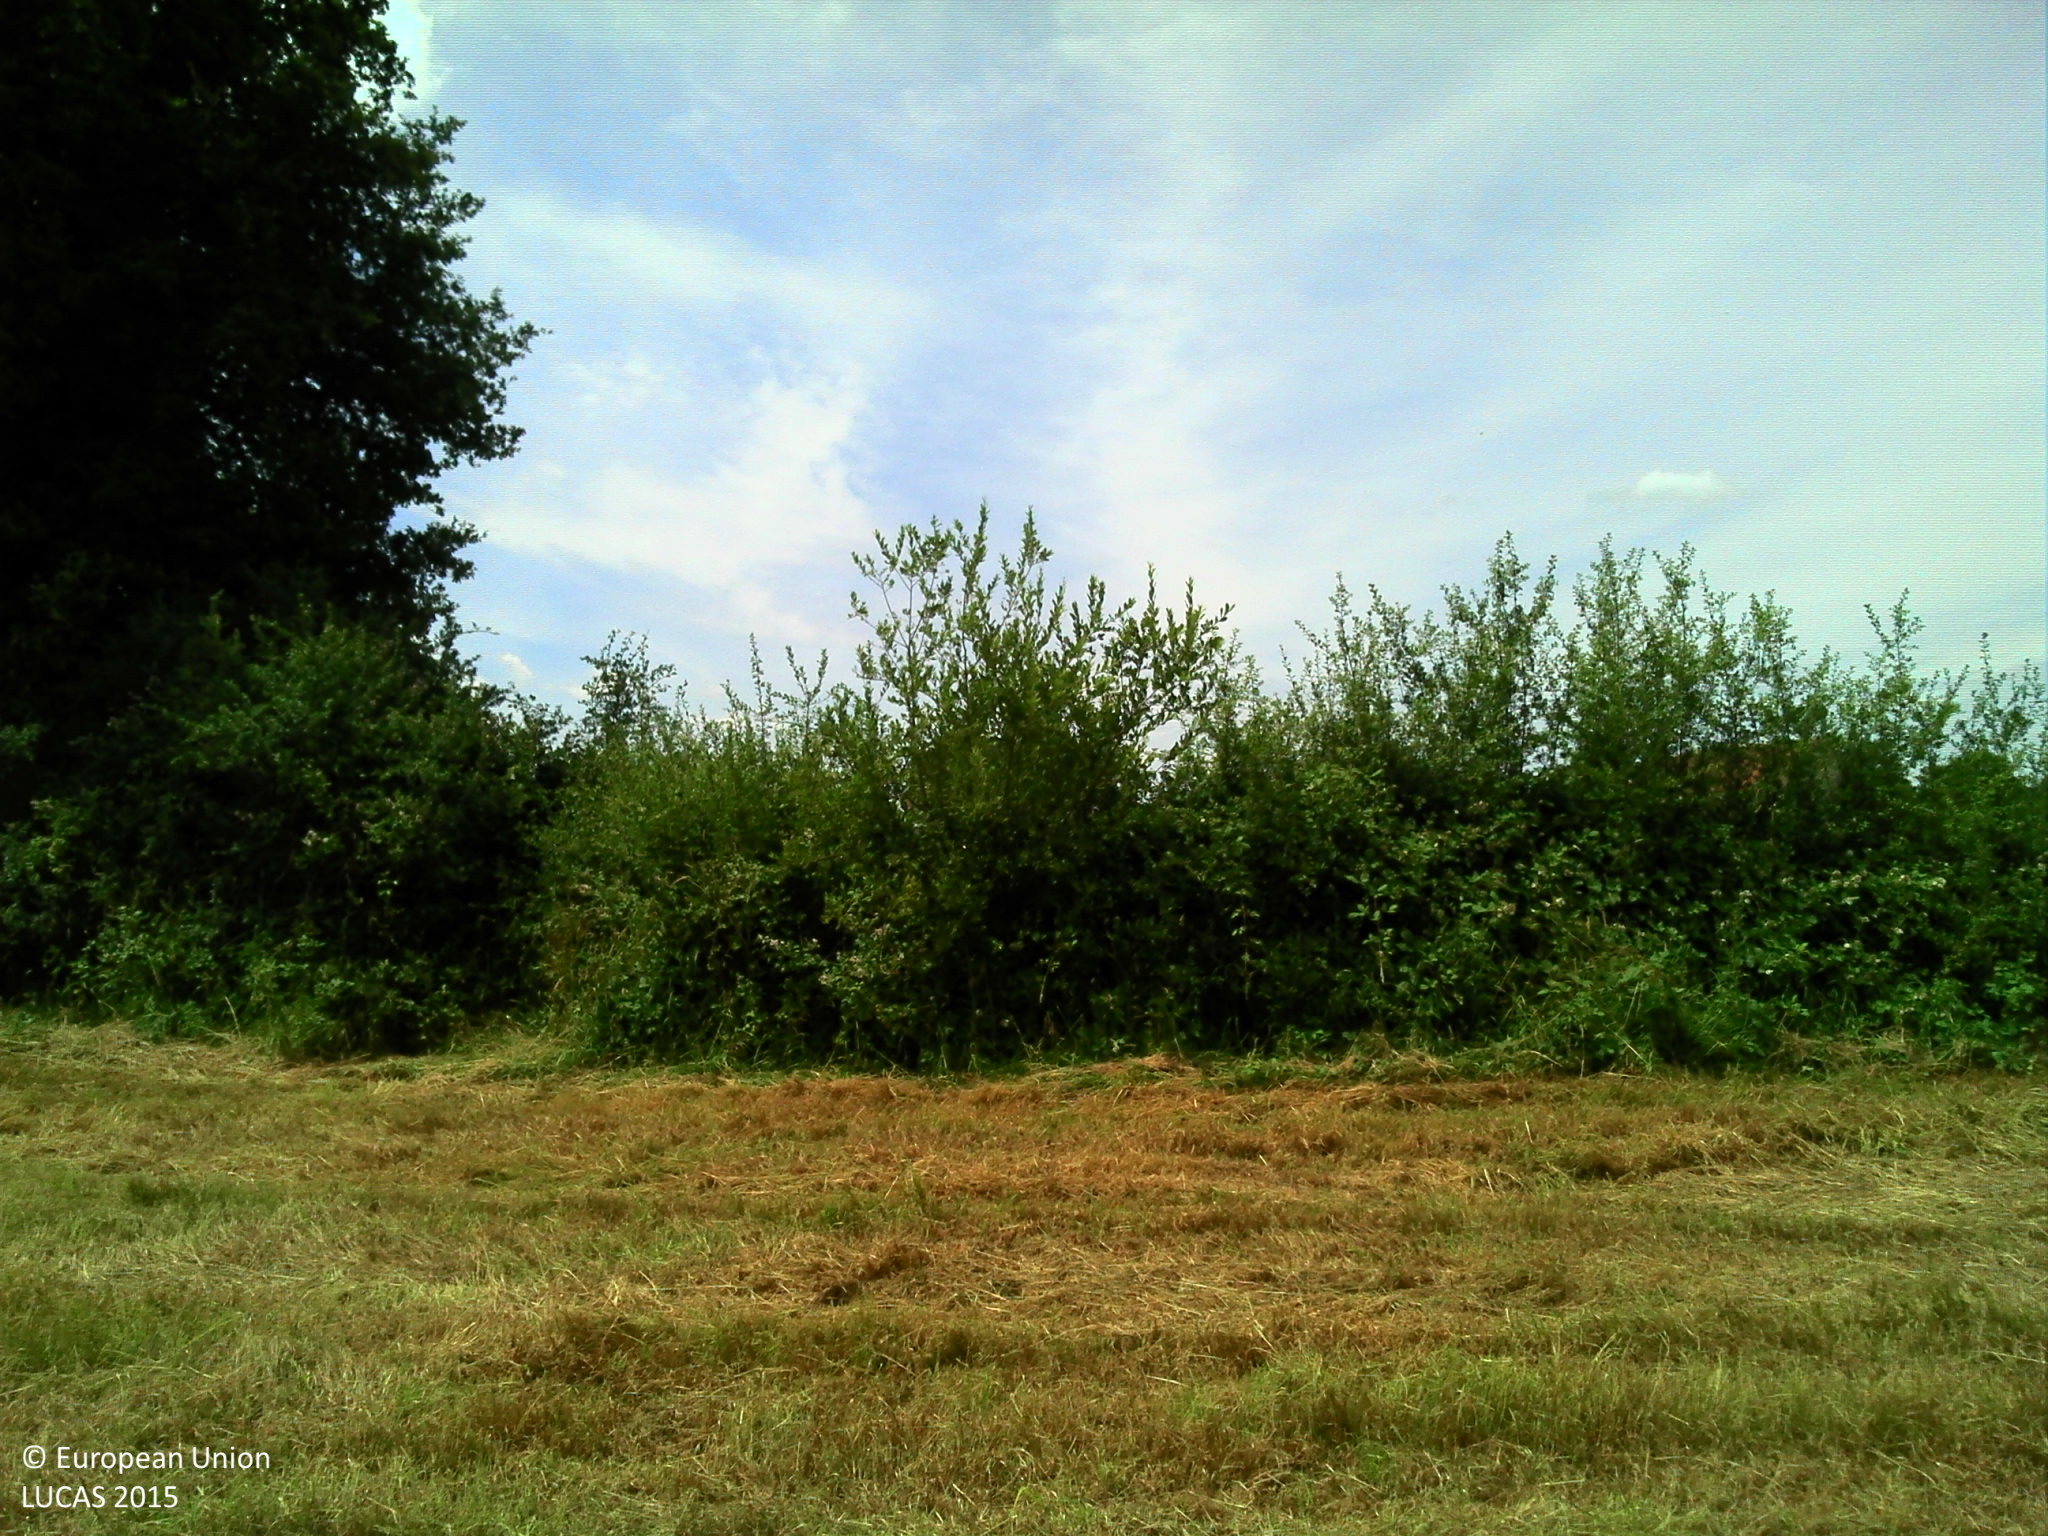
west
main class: Grassland
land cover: Grassland without tree/shrub cover
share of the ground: > 75 %
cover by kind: herbaceous plants 100 %
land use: Agriculture (excluding fallow land and kitchen gardens)
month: June
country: FR
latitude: 46.4267
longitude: 3.2446
